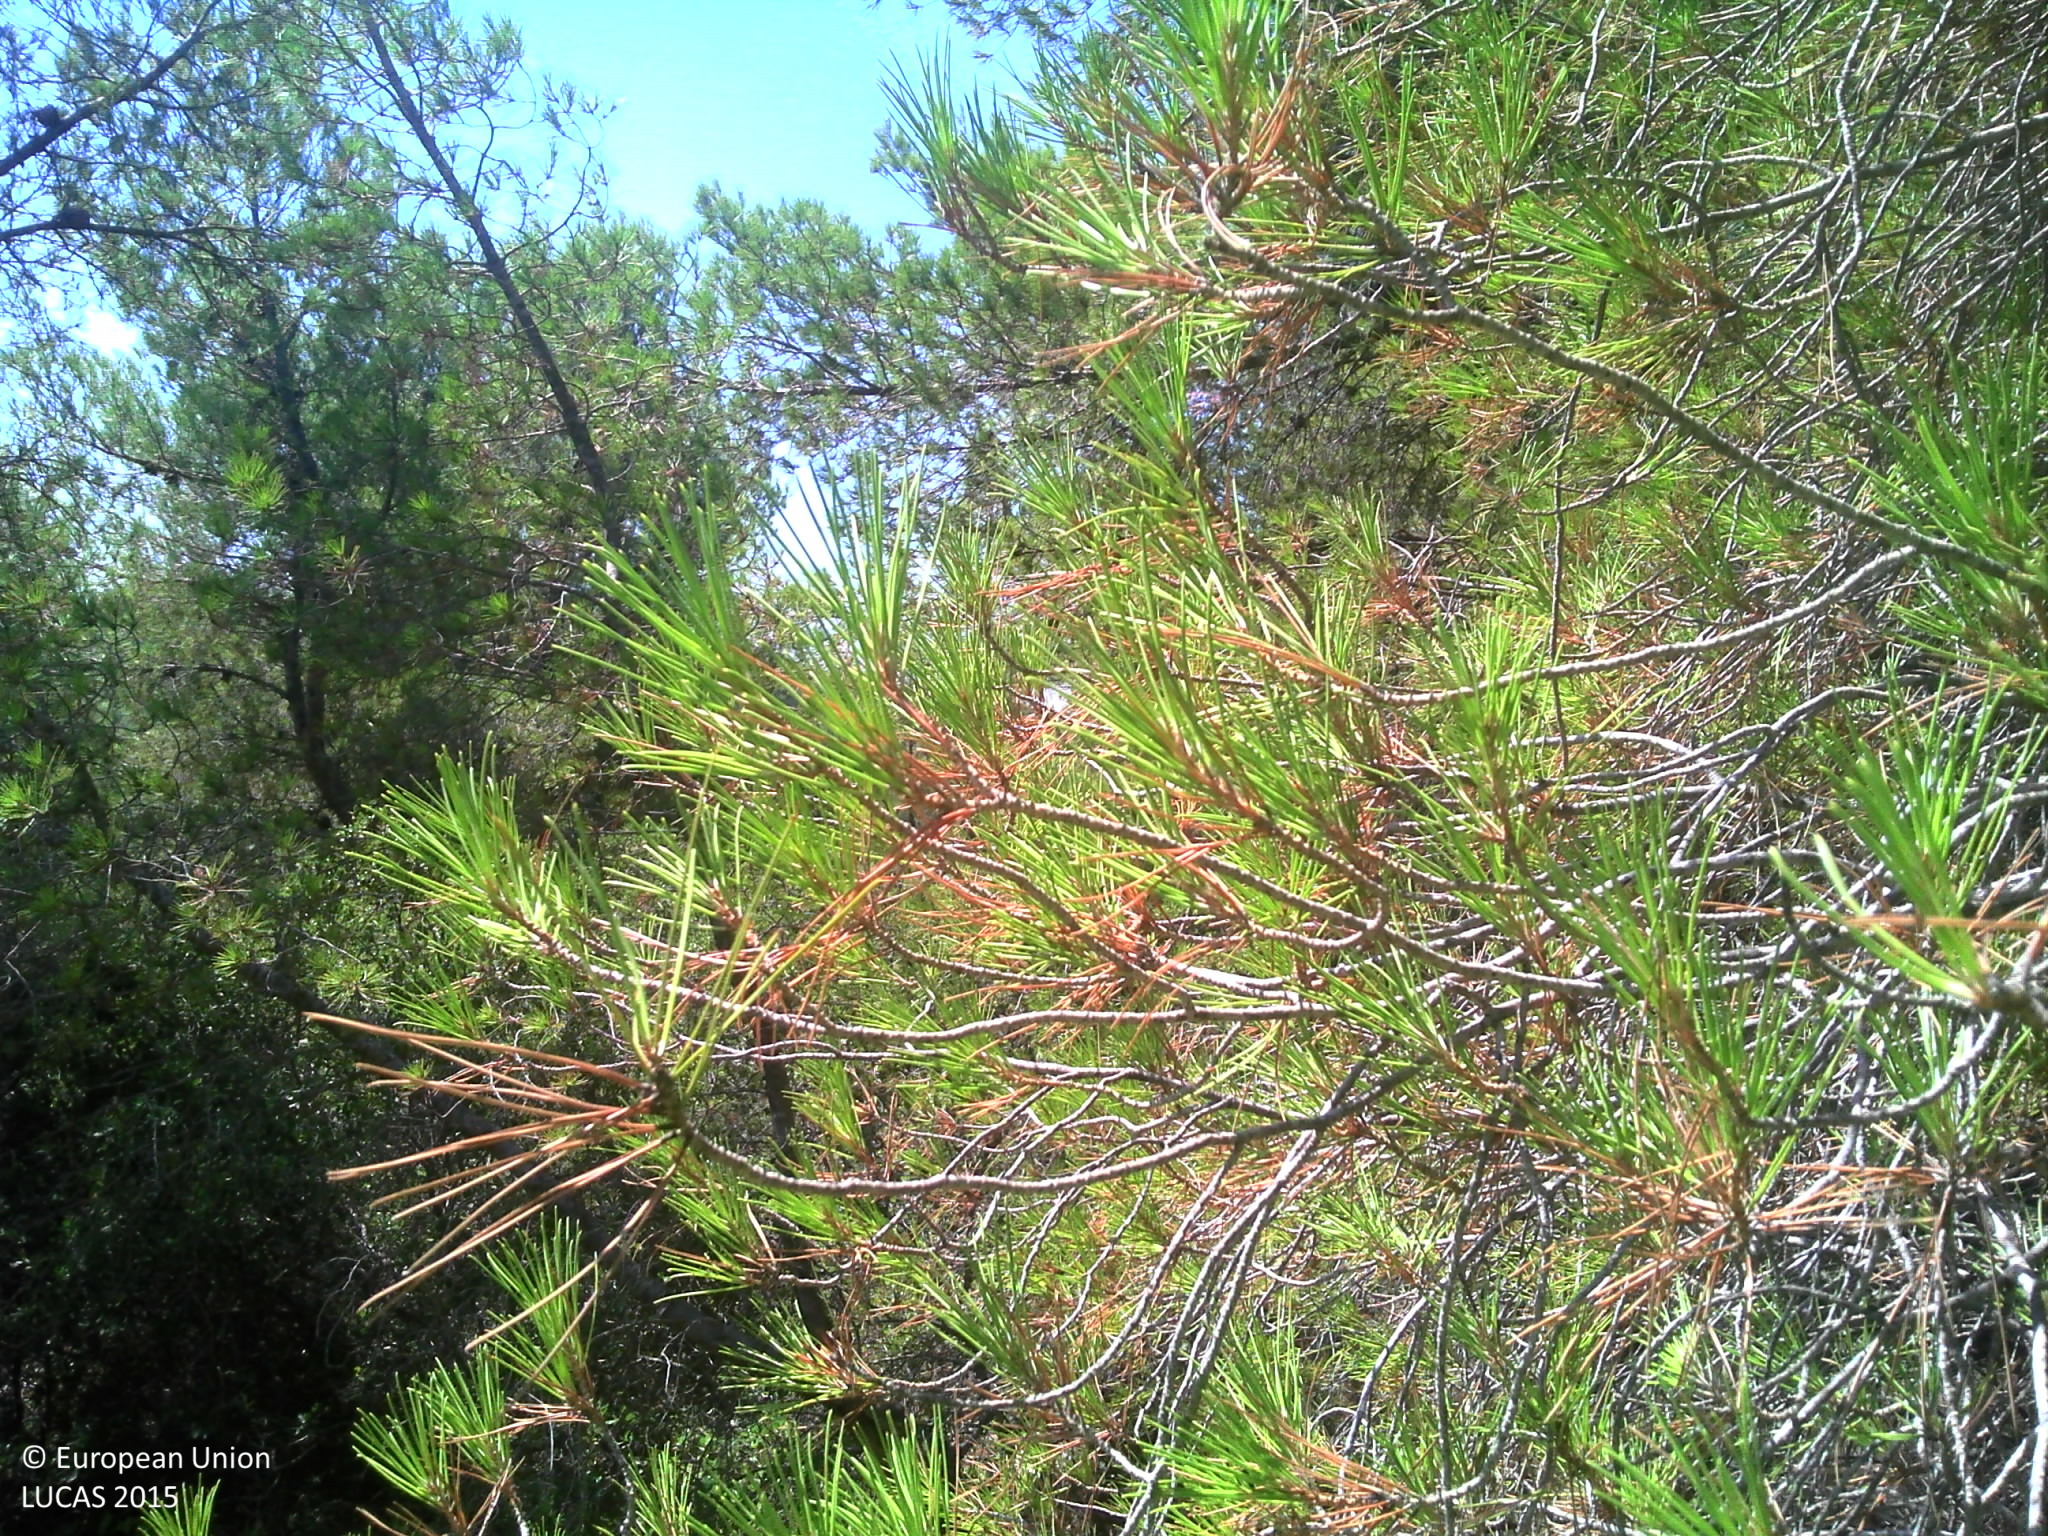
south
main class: Woodland
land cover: Pine dominated coniferous woodland
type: coniferous forest of the mediterranean region
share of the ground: > 75 %
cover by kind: coniferous forest trees 45 %, shrubs 25 %, consolidated bare surface 20 %, herbaceous plants 10 %
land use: Forestry
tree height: > 5 m
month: August
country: FR
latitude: 43.3679
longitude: 5.1111
